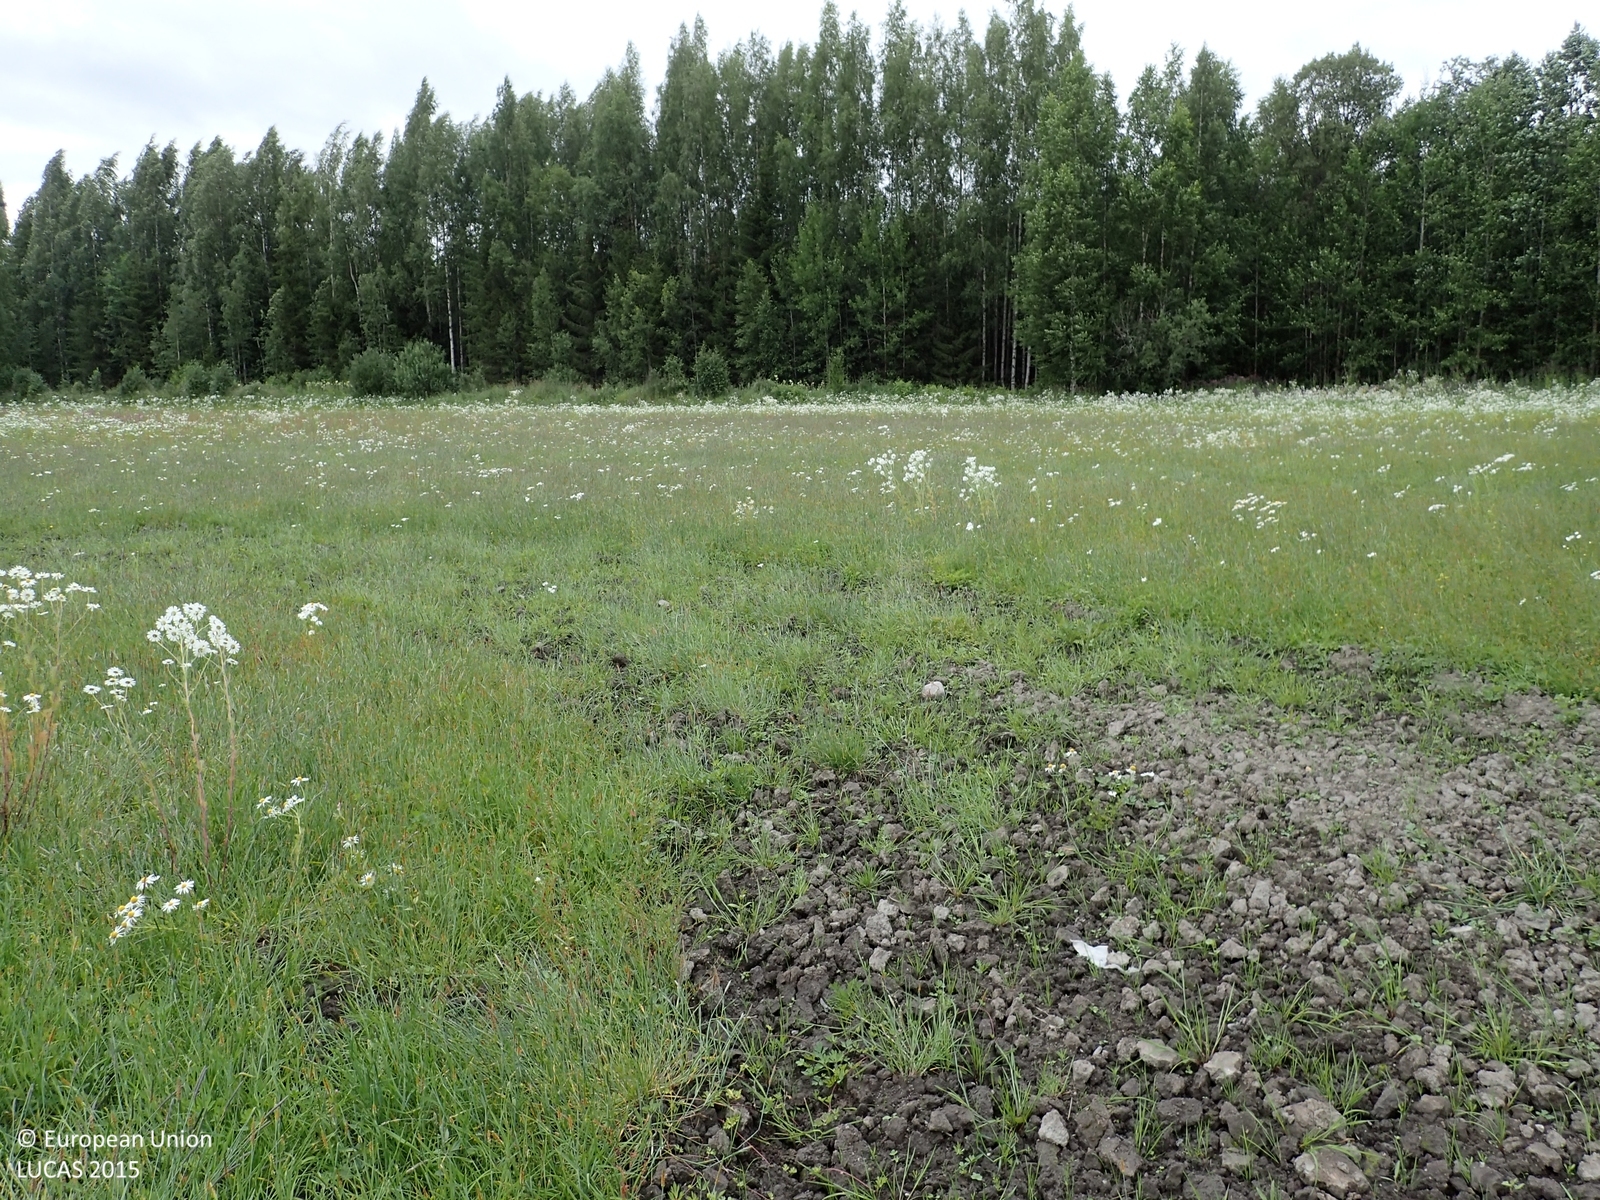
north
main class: Grassland
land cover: Spontaneously vegetated surfaces
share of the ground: 50 - 75 %
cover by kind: herbaceous plants 70 %, unconsolidated bare surface 30 %
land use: Fallow land
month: August
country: FI
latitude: 62.9400
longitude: 22.1652
